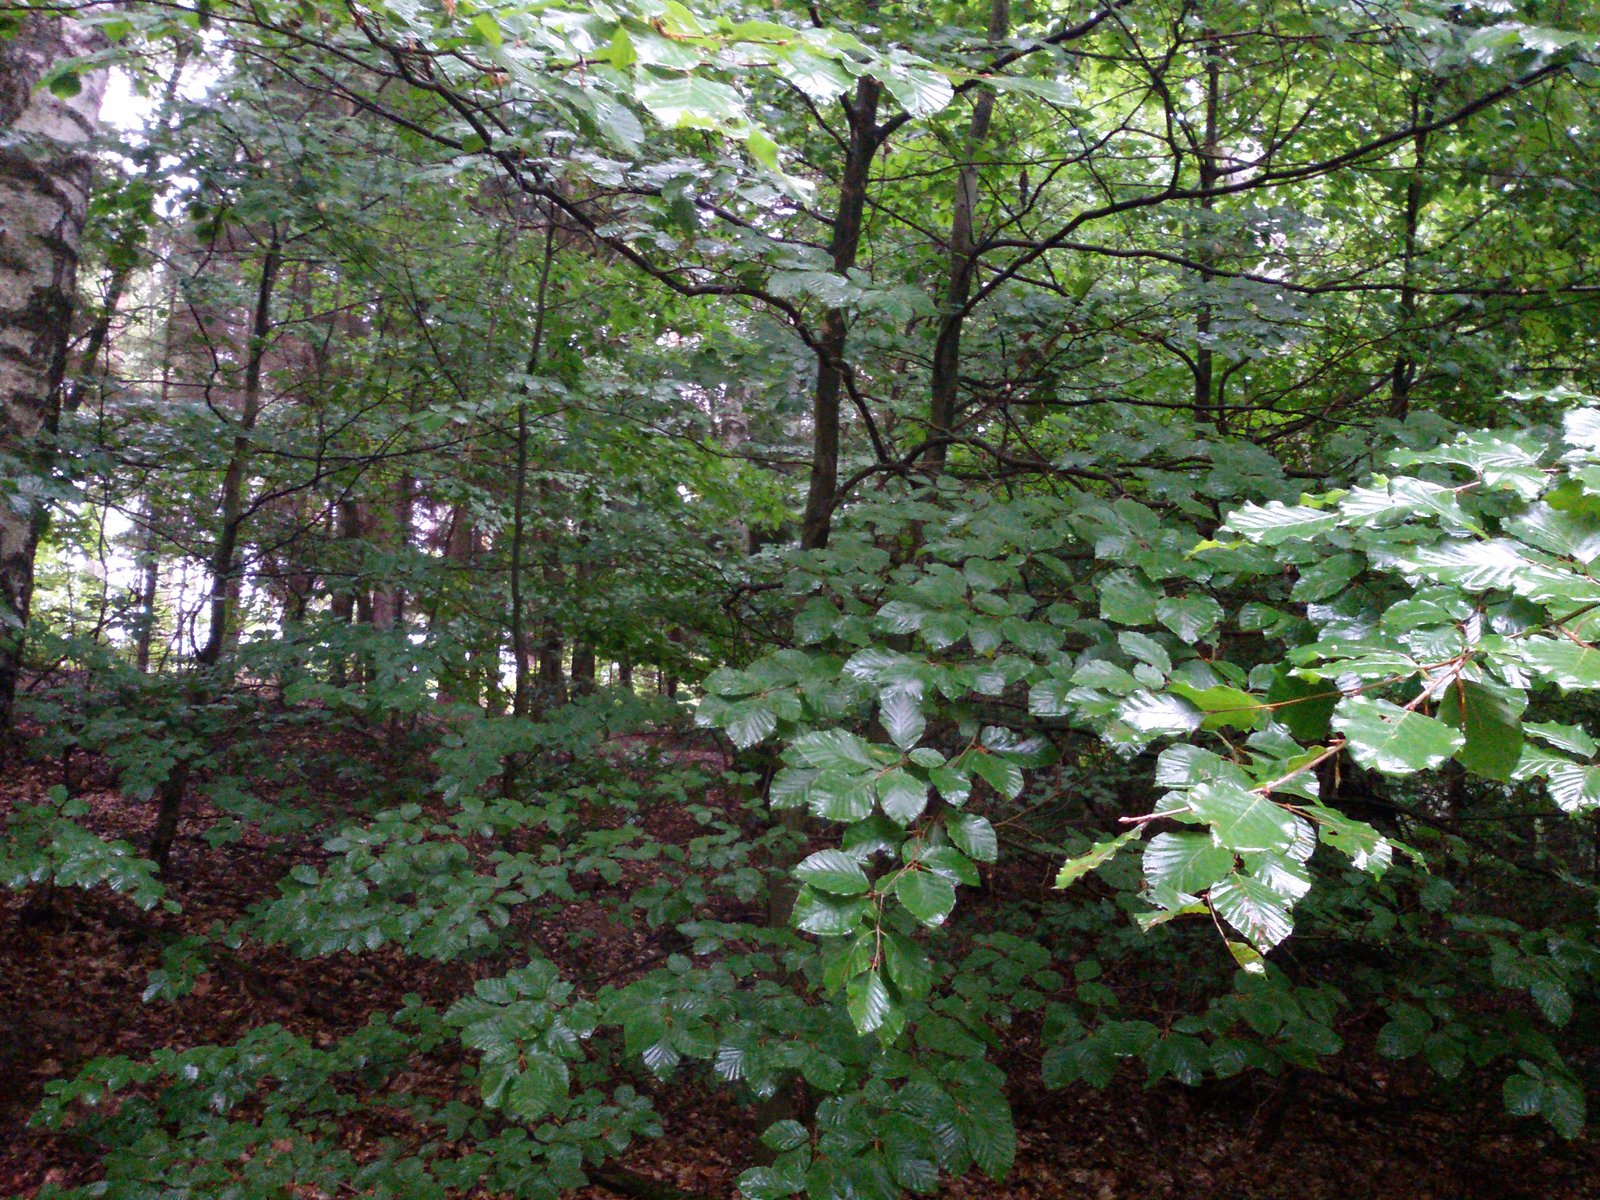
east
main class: Woodland
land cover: Broadleaved woodland
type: beech forest
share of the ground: > 75 %
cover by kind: broadleaved forest trees 90 %, herbaceous plants 5 %, lichens and mosses 5 %
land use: Forestry
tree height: > 5 m
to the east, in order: Broadleaved woodland; Spruce dominated coniferous woodland; Pine dominated mixed woodland; Grass margins; Tracks; Grass margins; Fences; Permanent industrial crops
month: July
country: PL
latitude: 53.7678
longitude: 17.1552
